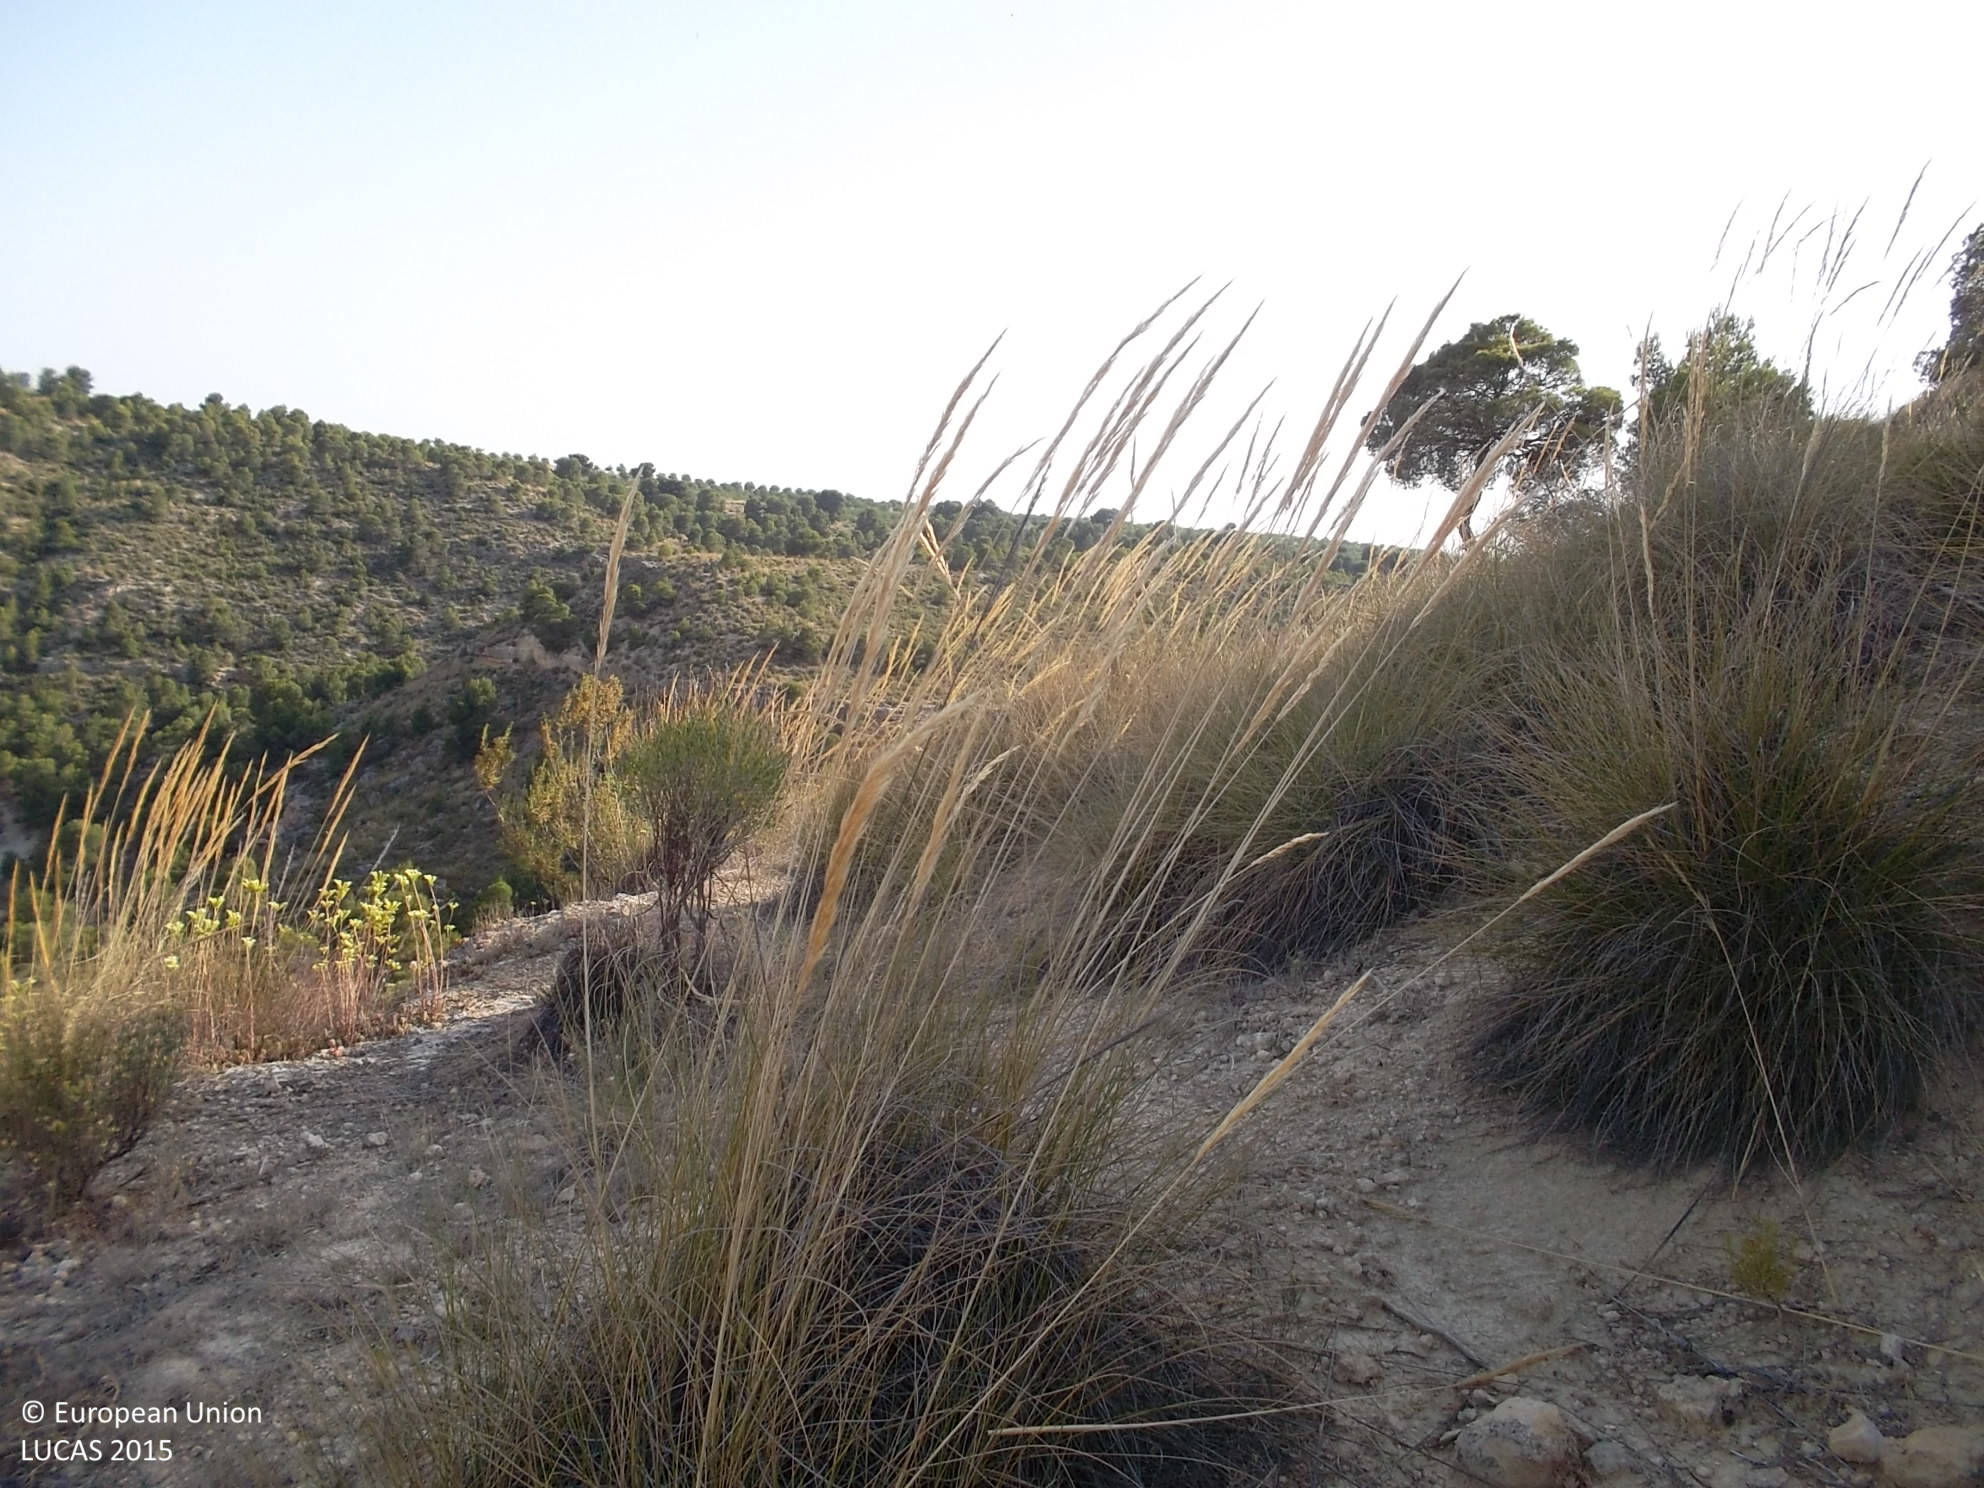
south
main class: Grassland
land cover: Grassland without tree/shrub cover
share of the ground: > 75 %
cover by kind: herbaceous plants 95 %, shrubs 5 %
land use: Agriculture (excluding fallow land and kitchen gardens)
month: June
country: ES
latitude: 37.6834
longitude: -2.8150
